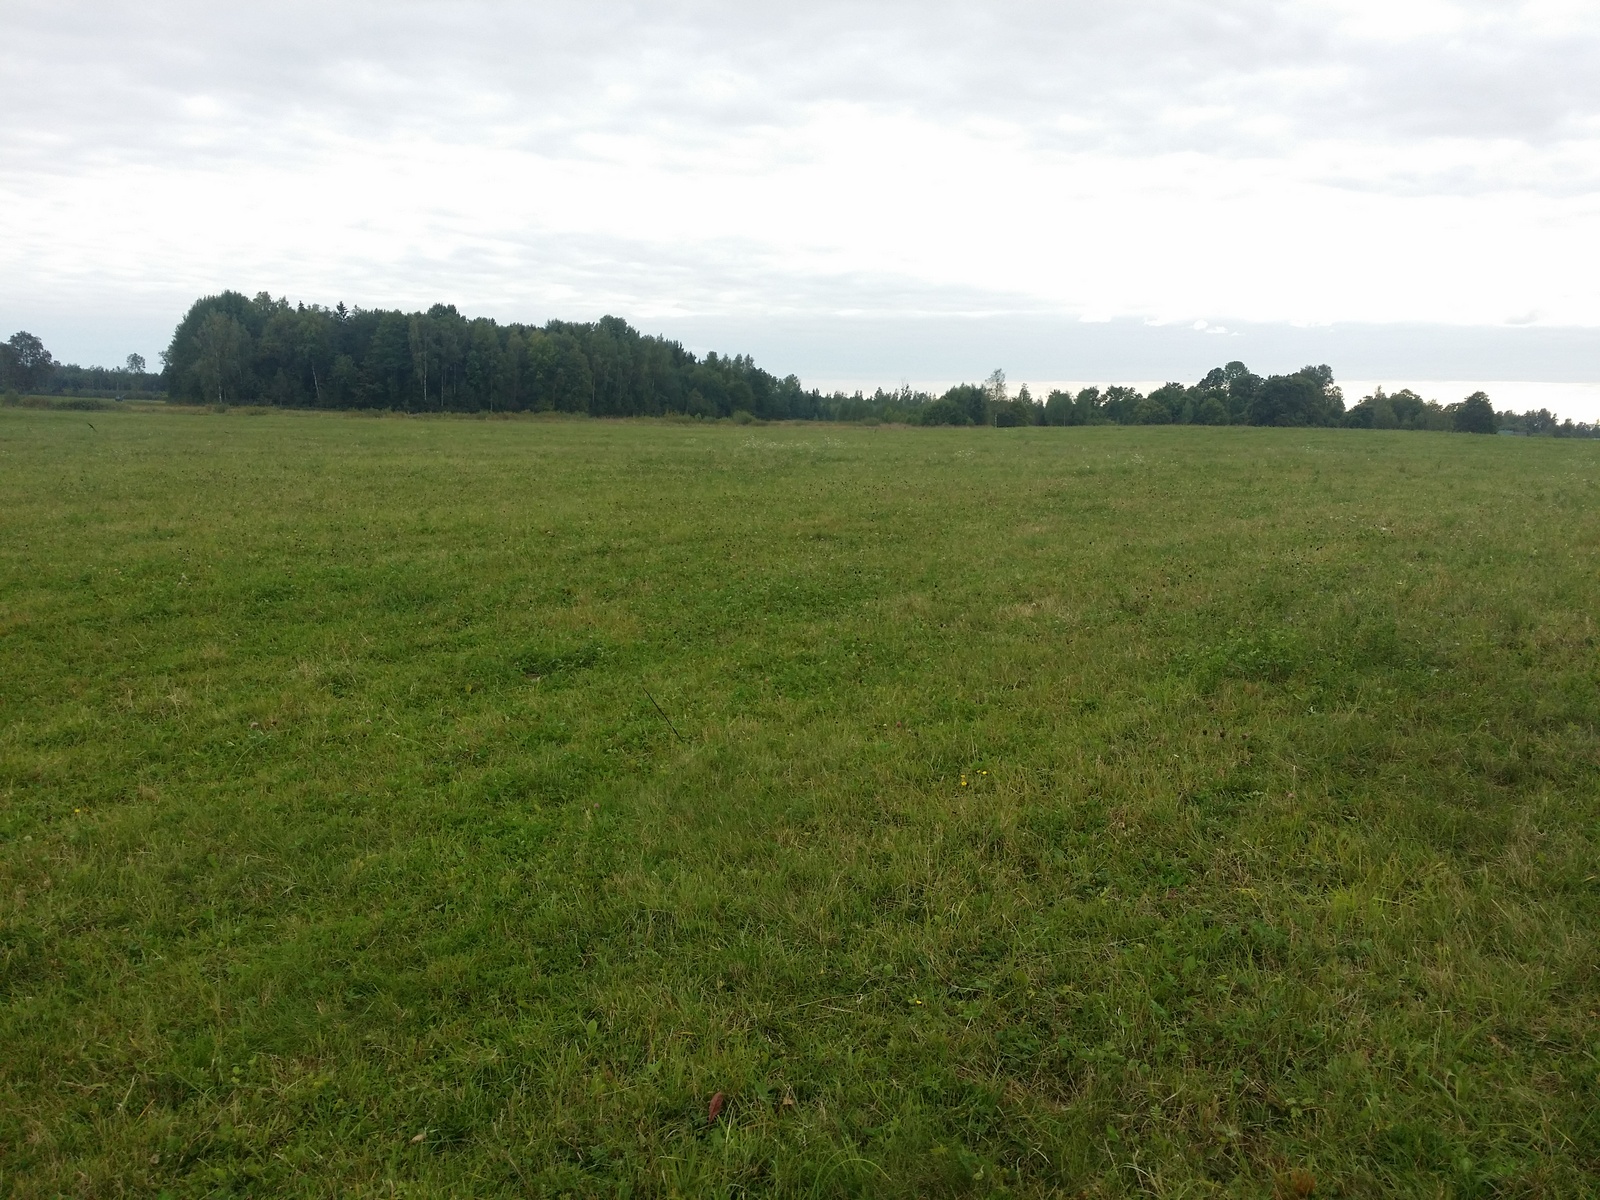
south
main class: Grassland
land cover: Grassland without tree/shrub cover
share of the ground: > 75 %
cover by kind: herbaceous plants 95 %, unconsolidated bare surface 5 %
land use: Agriculture (excluding fallow land and kitchen gardens)
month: September
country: LV
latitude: 56.9819
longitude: 27.0955
